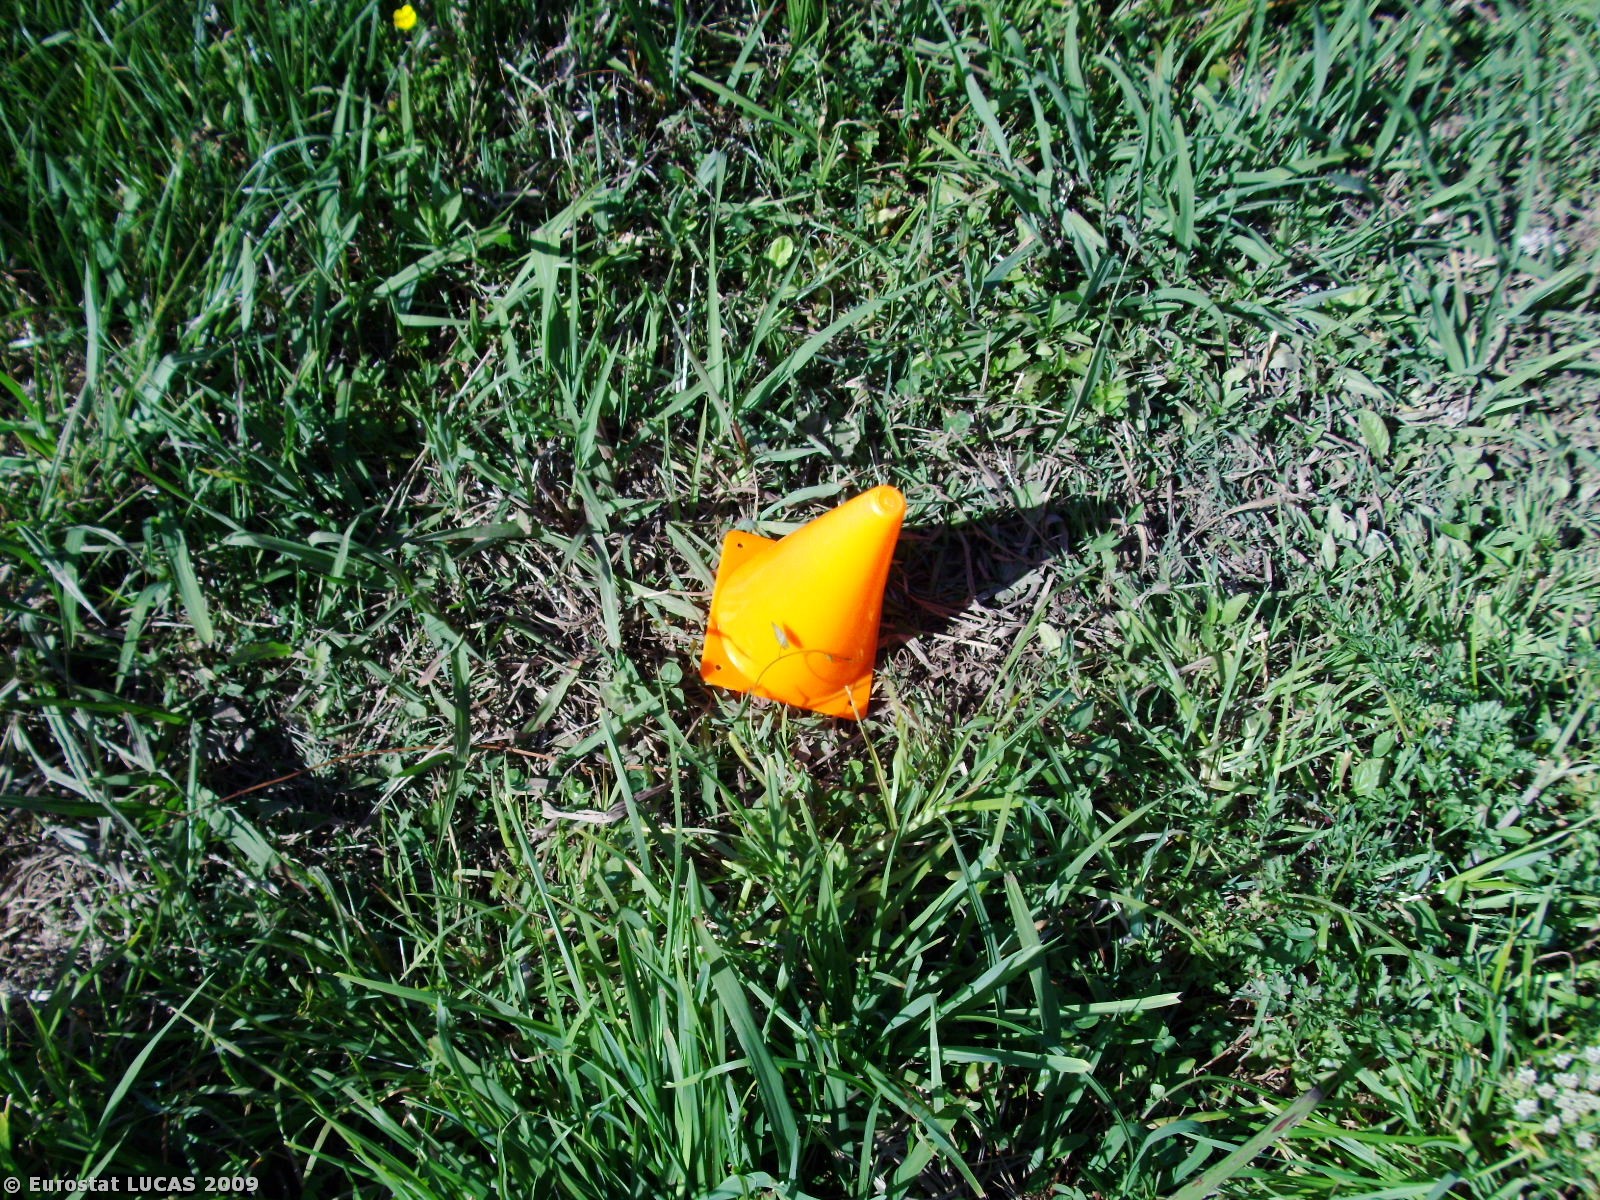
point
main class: Grassland
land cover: Spontaneously vegetated surfaces
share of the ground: > 75 %
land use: Fallow land
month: May
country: PT
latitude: 40.5746
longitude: -8.4355
